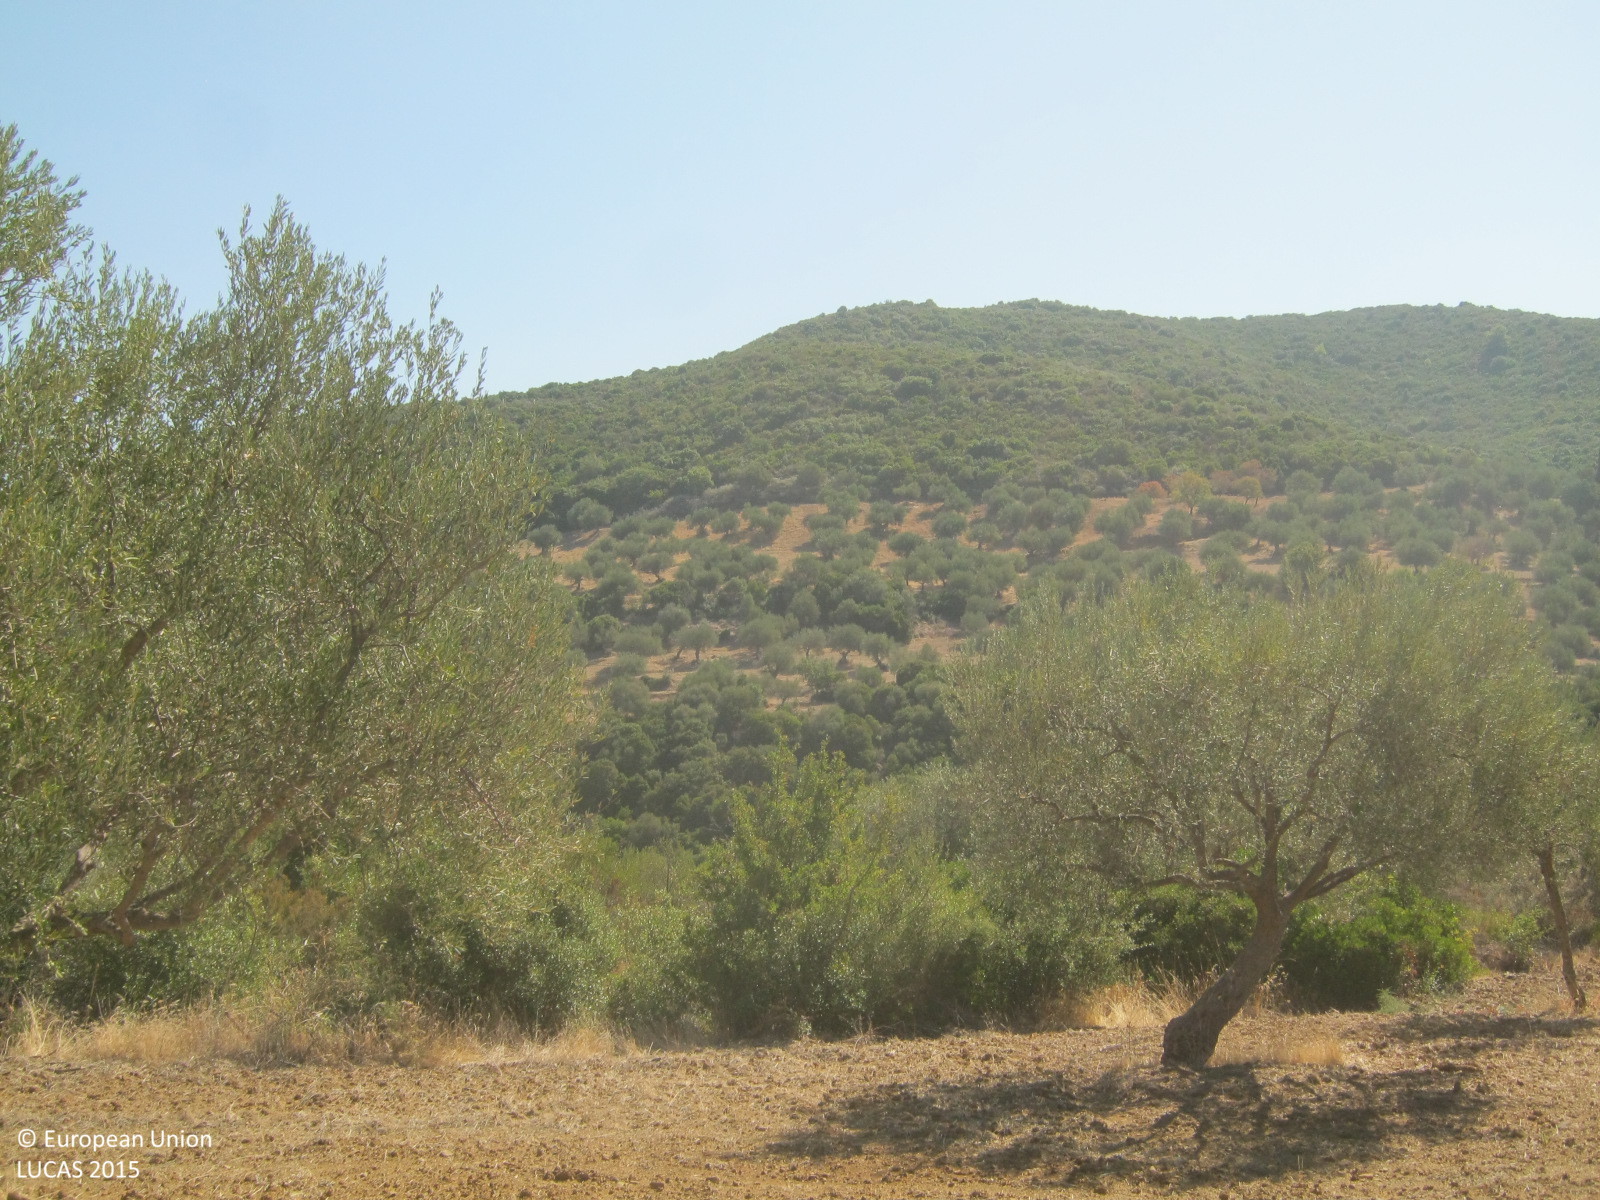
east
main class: Cropland
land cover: Olive groves
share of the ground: 25 - 50 %
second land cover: Other bare soil
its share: > 75 %
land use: Agriculture (excluding fallow land and kitchen gardens)
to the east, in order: Olive groves; Other bare soil; Shrubland without tree cover; Other mixed woodland; Shrubland with sparse tree cover; Rivers and streams; Shrubland with sparse tree cover; Olive groves; Tracks; Shrubland with sparse tree cover; Olive groves; Grass margins; Tracks; Olive groves
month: September
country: GR
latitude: 38.0542
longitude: 21.6458
